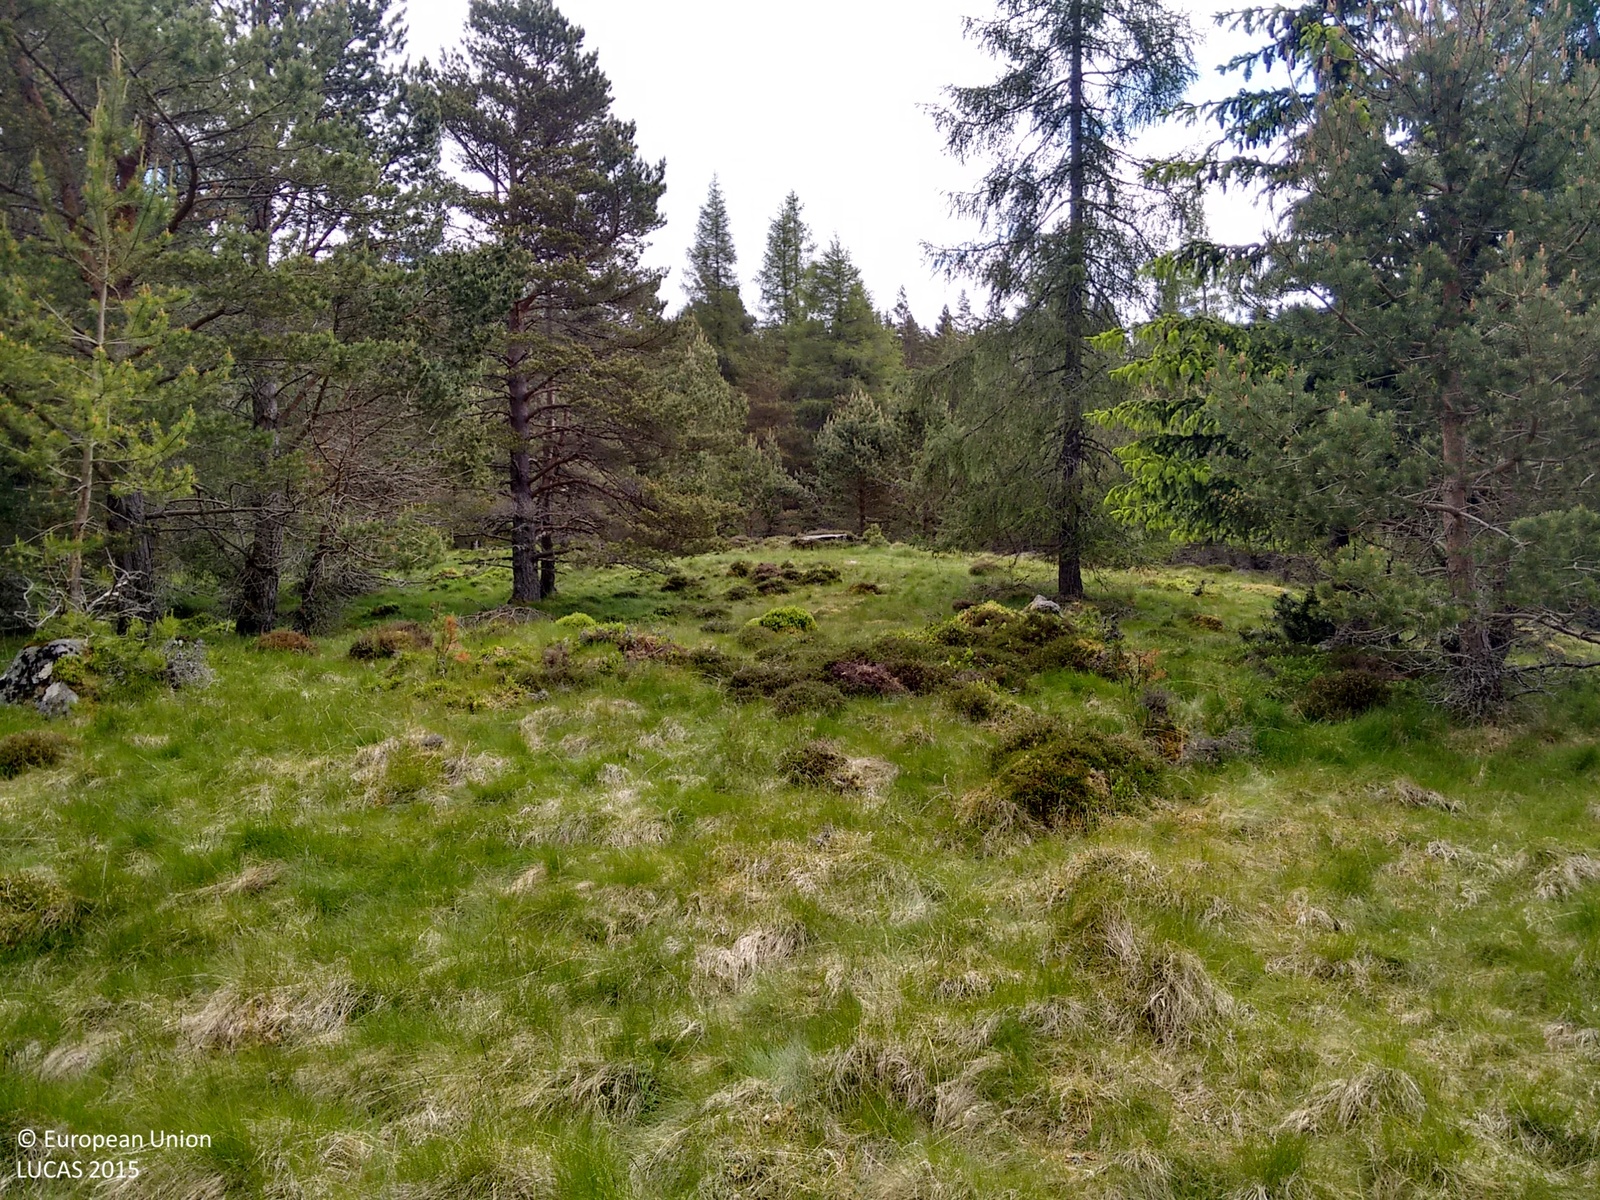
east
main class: Woodland
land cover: Pine dominated coniferous woodland
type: exotic forest
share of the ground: > 75 %
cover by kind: herbaceous plants 60 %, coniferous forest trees 30 %, shrubs 10 %
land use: Semi-natural and natural areas not in use
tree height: > 5 m
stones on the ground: < 10 %
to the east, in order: Pine dominated coniferous woodland; Tracks; Pine dominated coniferous woodland; Rocks and stones; Pine dominated coniferous woodland; Tracks; Rocks and stones; Pine dominated coniferous woodland; Tracks; Rocks and stones; Pine dominated coniferous woodland
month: June
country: GB
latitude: 57.0317
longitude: -3.2325
